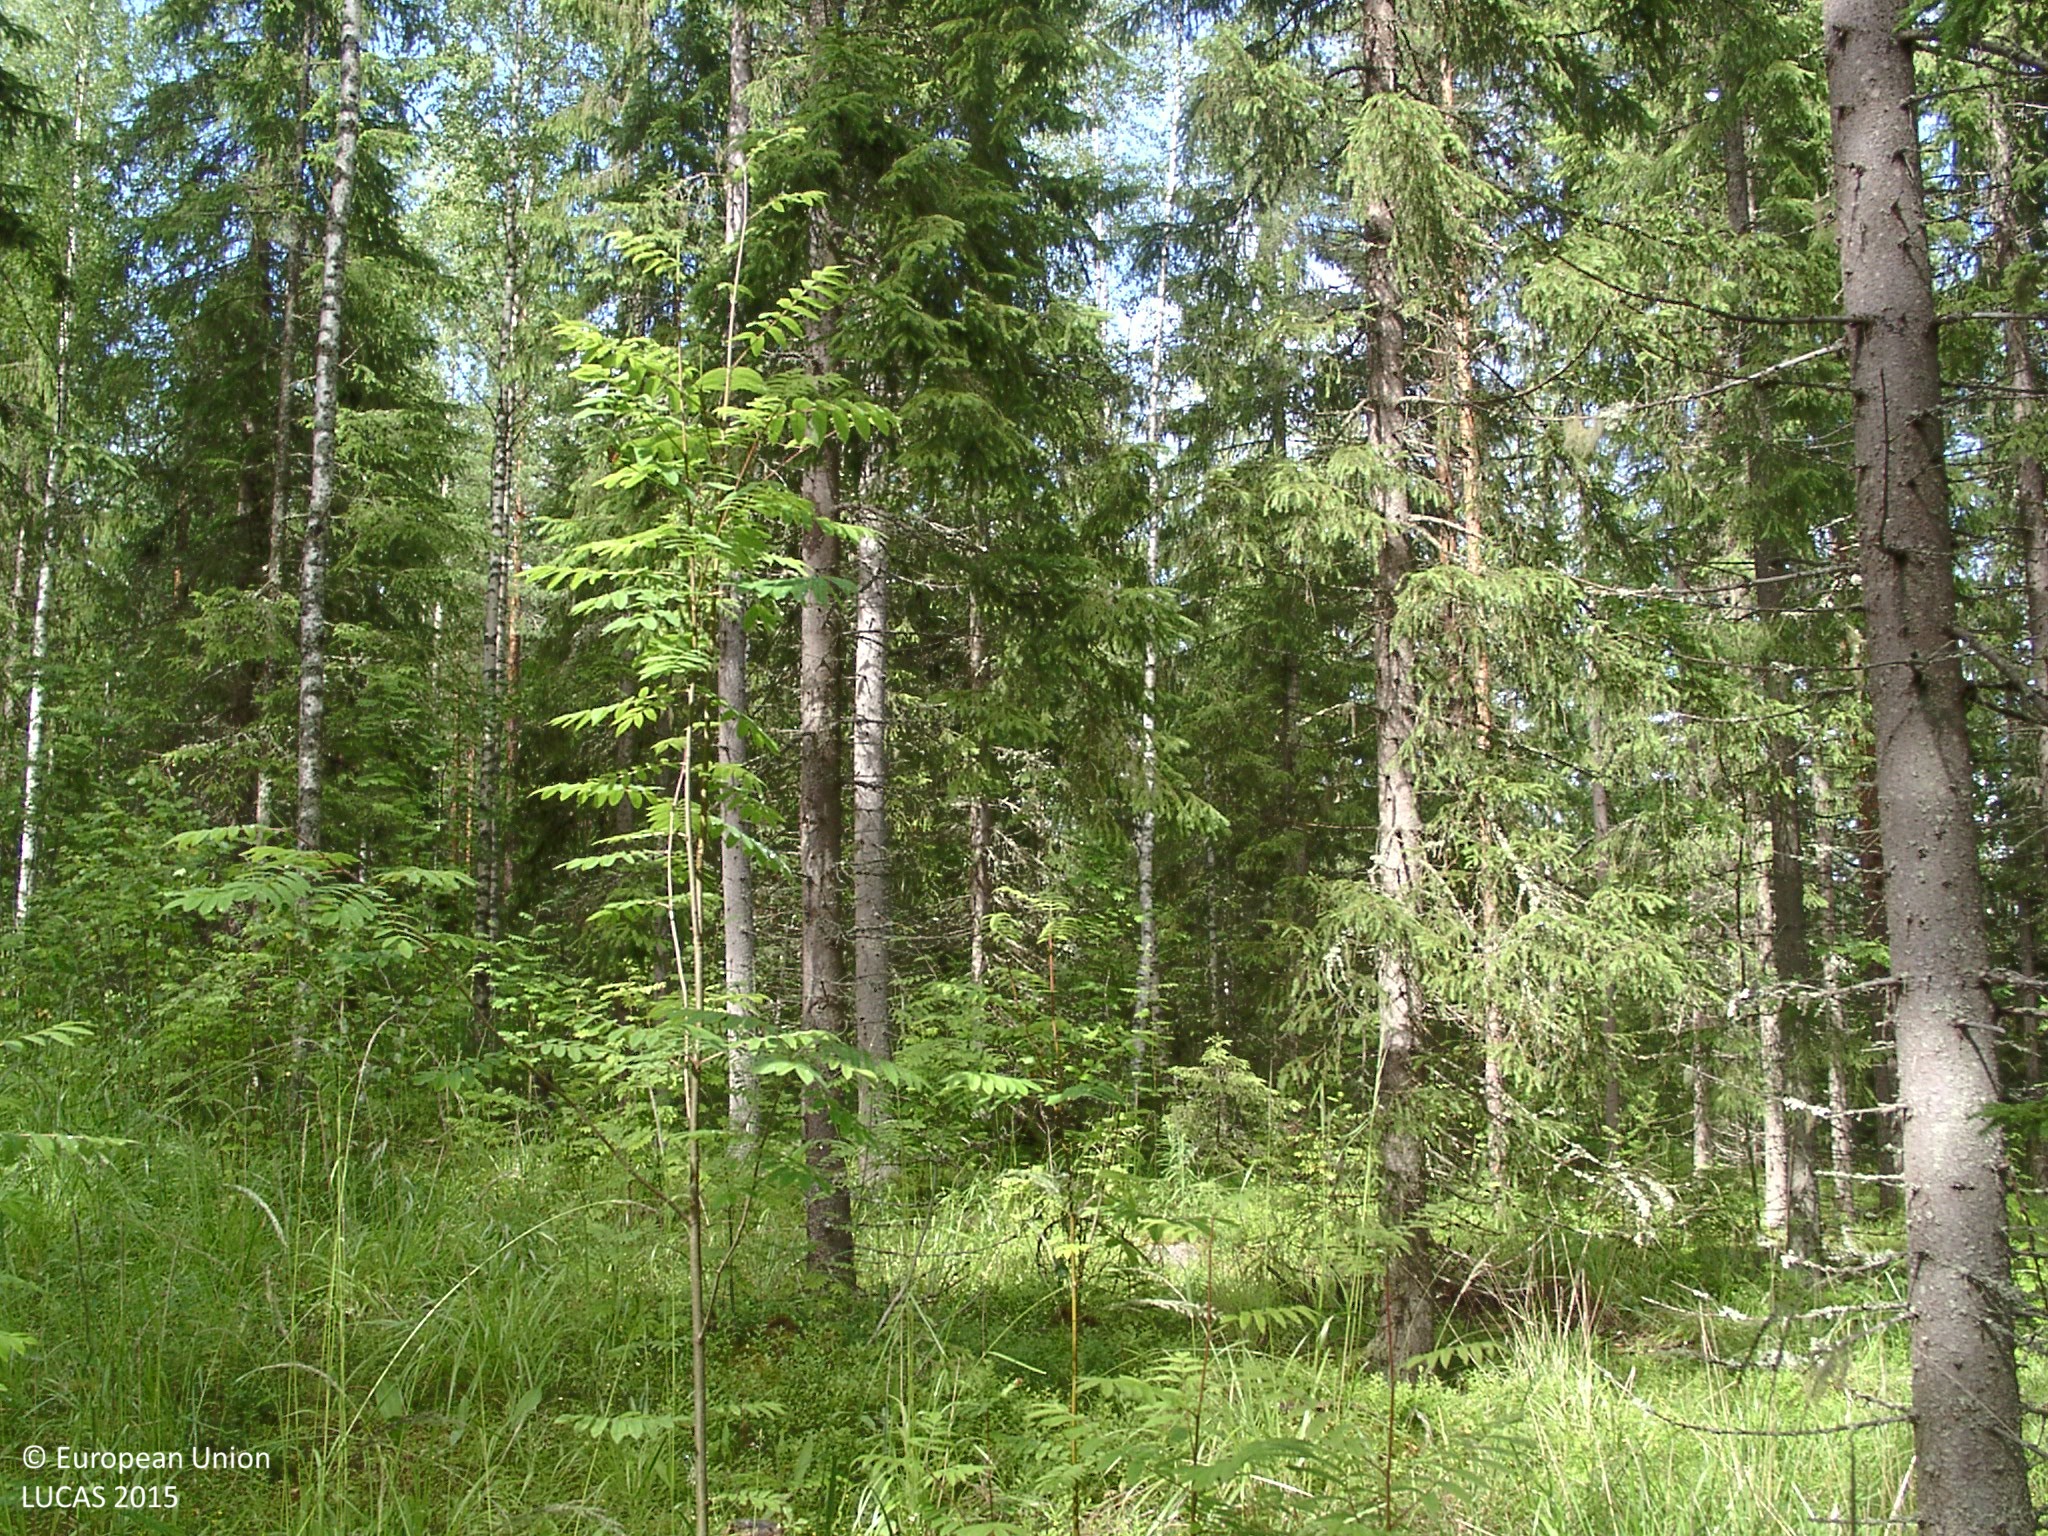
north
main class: Woodland
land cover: Other coniferous woodland
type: boreal forest
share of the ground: 50 - 75 %
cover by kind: coniferous forest trees 55 %, broadleaved forest trees 15 %, shrubs 15 %, lichens and mosses 10 %, herbaceous plants 5 %
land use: Forestry
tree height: > 5 m
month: July
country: FI
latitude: 61.9207
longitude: 25.2517
